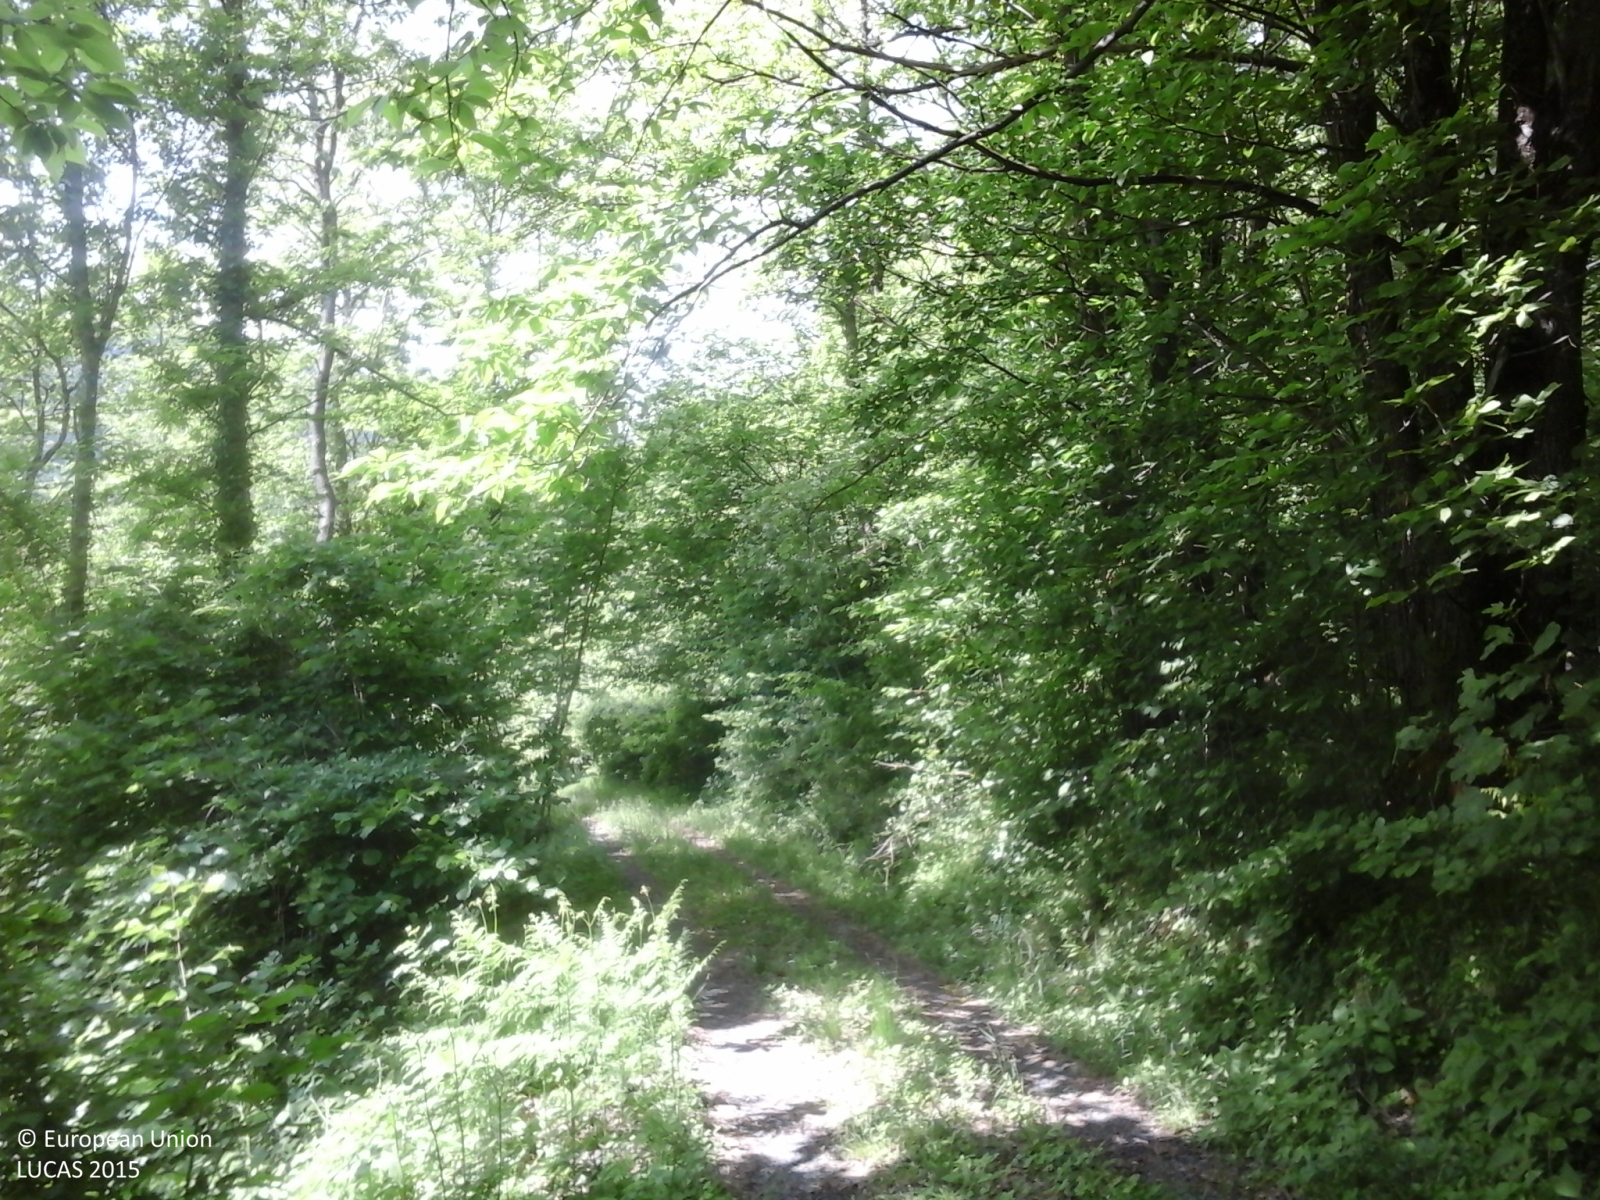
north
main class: Woodland
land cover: Broadleaved woodland
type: thermophilous deciduous forest
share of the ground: > 75 %
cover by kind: broadleaved forest trees 70 %, shrubs 30 %
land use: Forestry
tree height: > 5 m
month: May
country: IT
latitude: 44.4398
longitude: 9.5613
